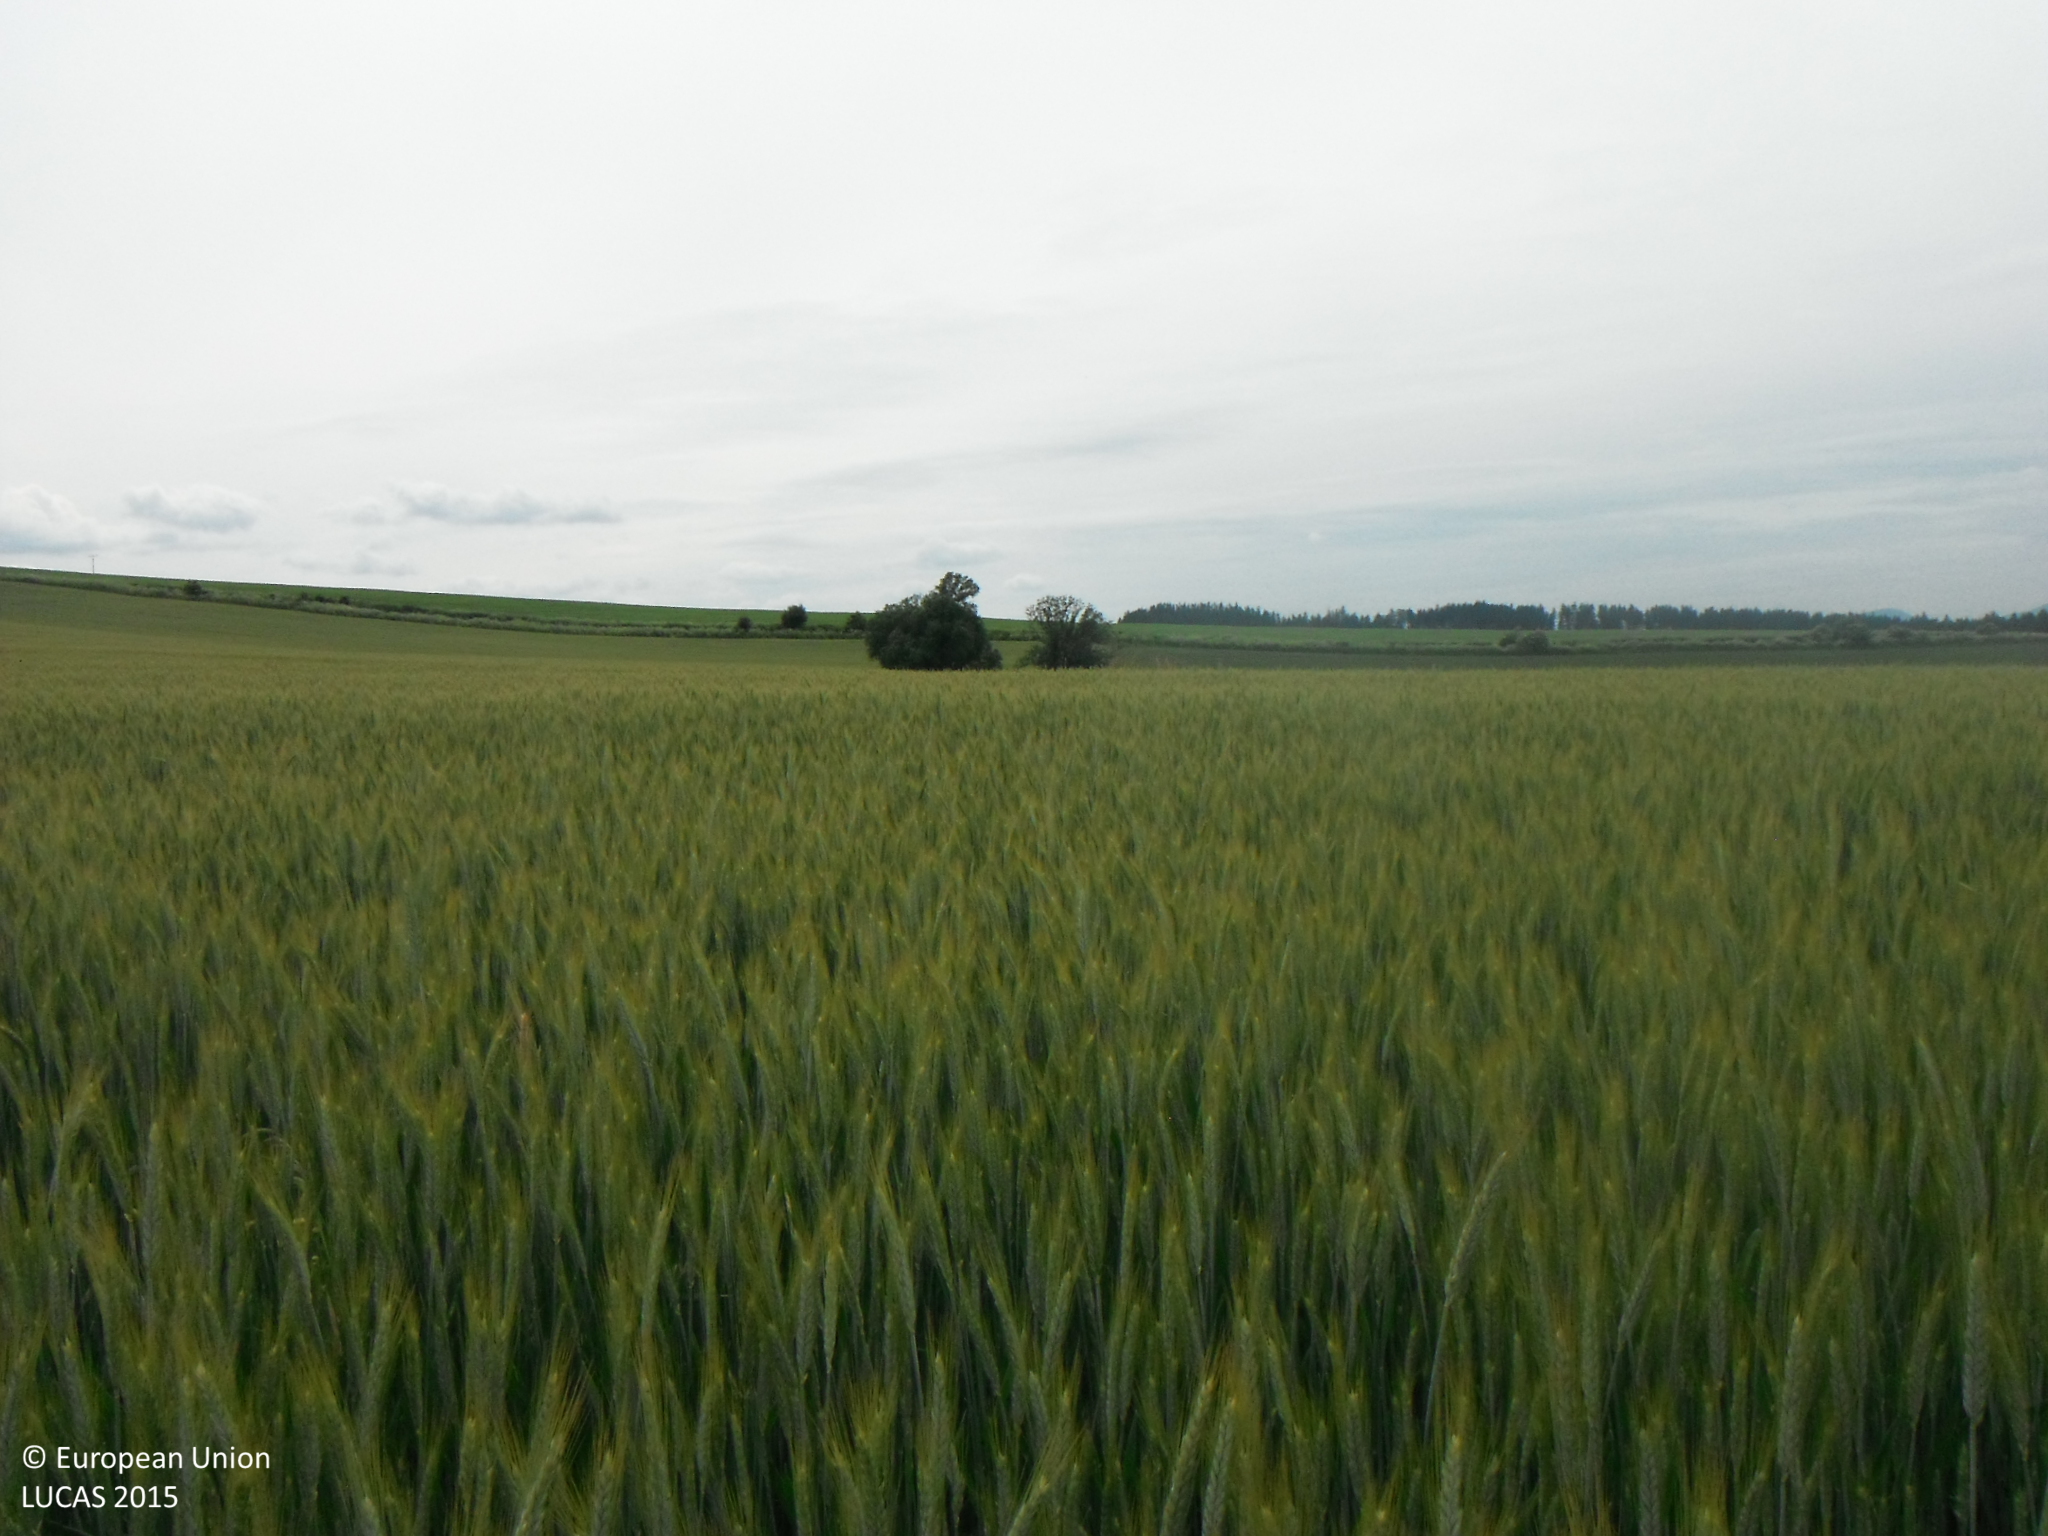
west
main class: Cropland
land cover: Rye
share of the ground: > 75 %
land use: Agriculture (excluding fallow land and kitchen gardens)
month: June
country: SK
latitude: 49.0793
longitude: 19.5138
